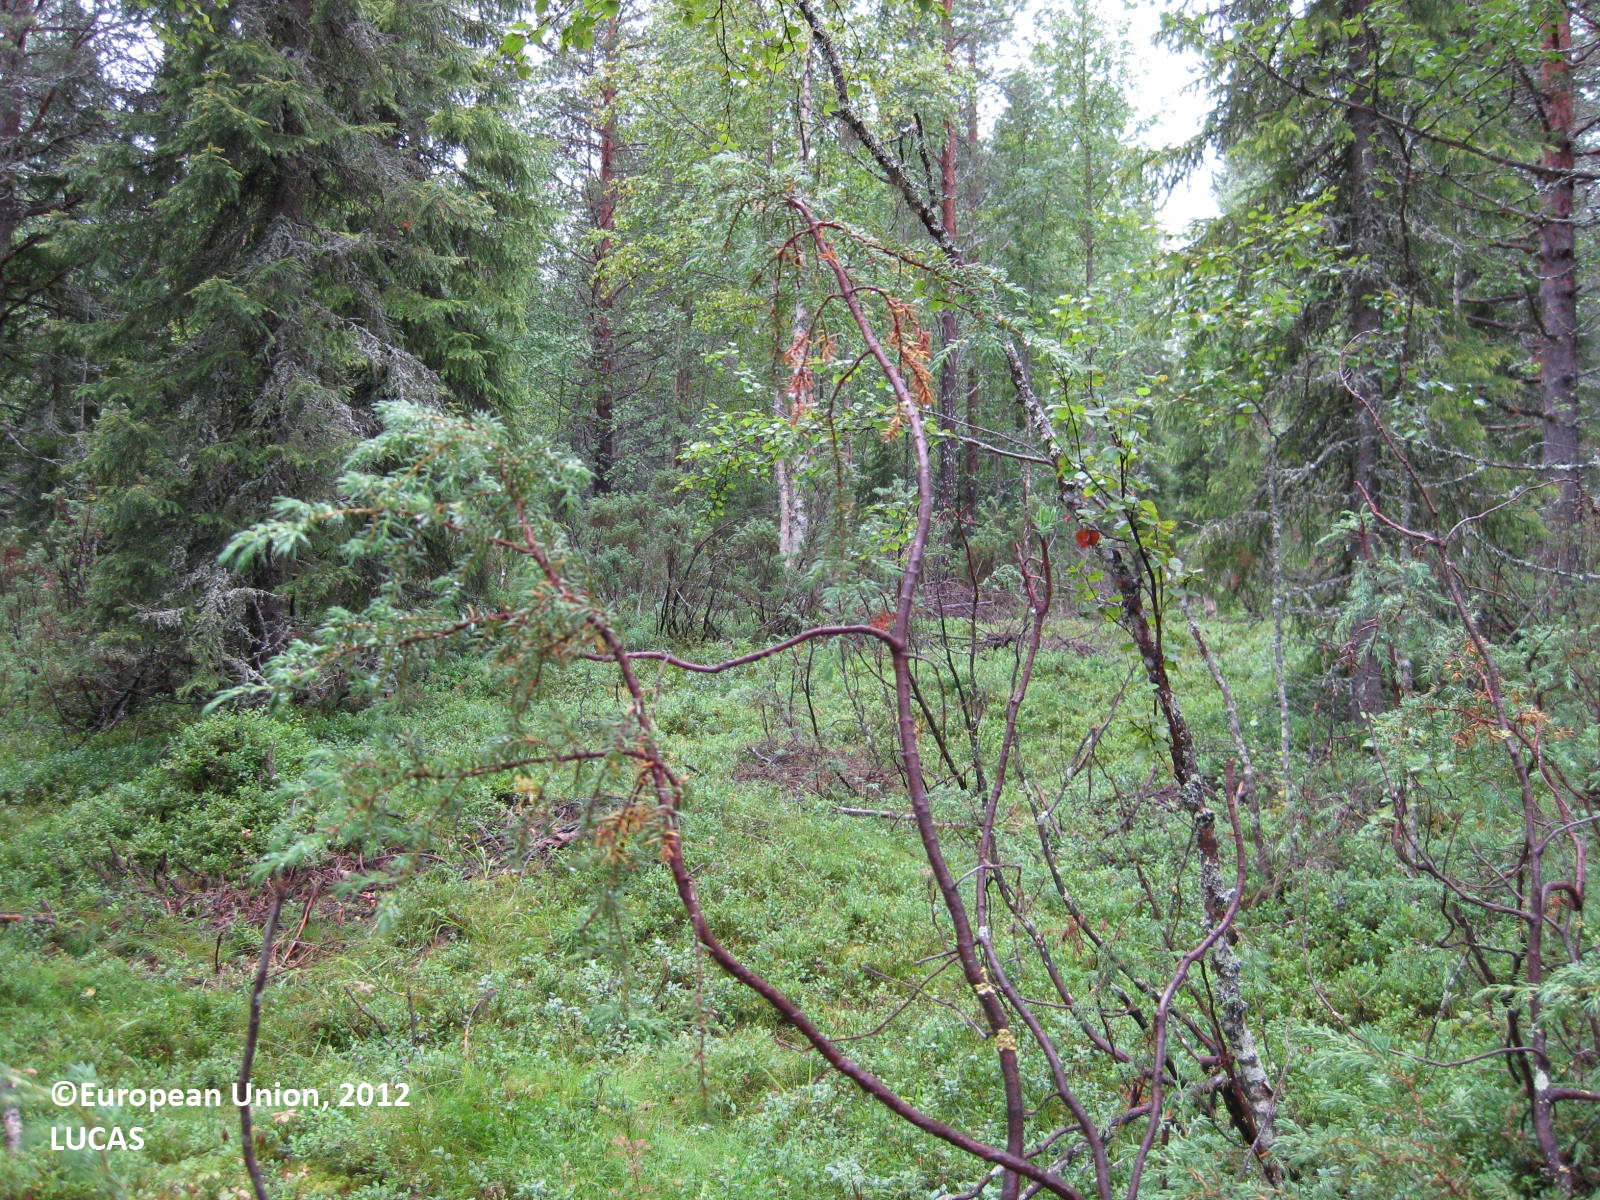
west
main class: Woodland
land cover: Other mixed woodland
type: boreal forest
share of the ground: 50 - 75 %
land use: Forestry
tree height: > 5 m
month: August
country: FI
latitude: 65.8118
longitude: 28.0554
